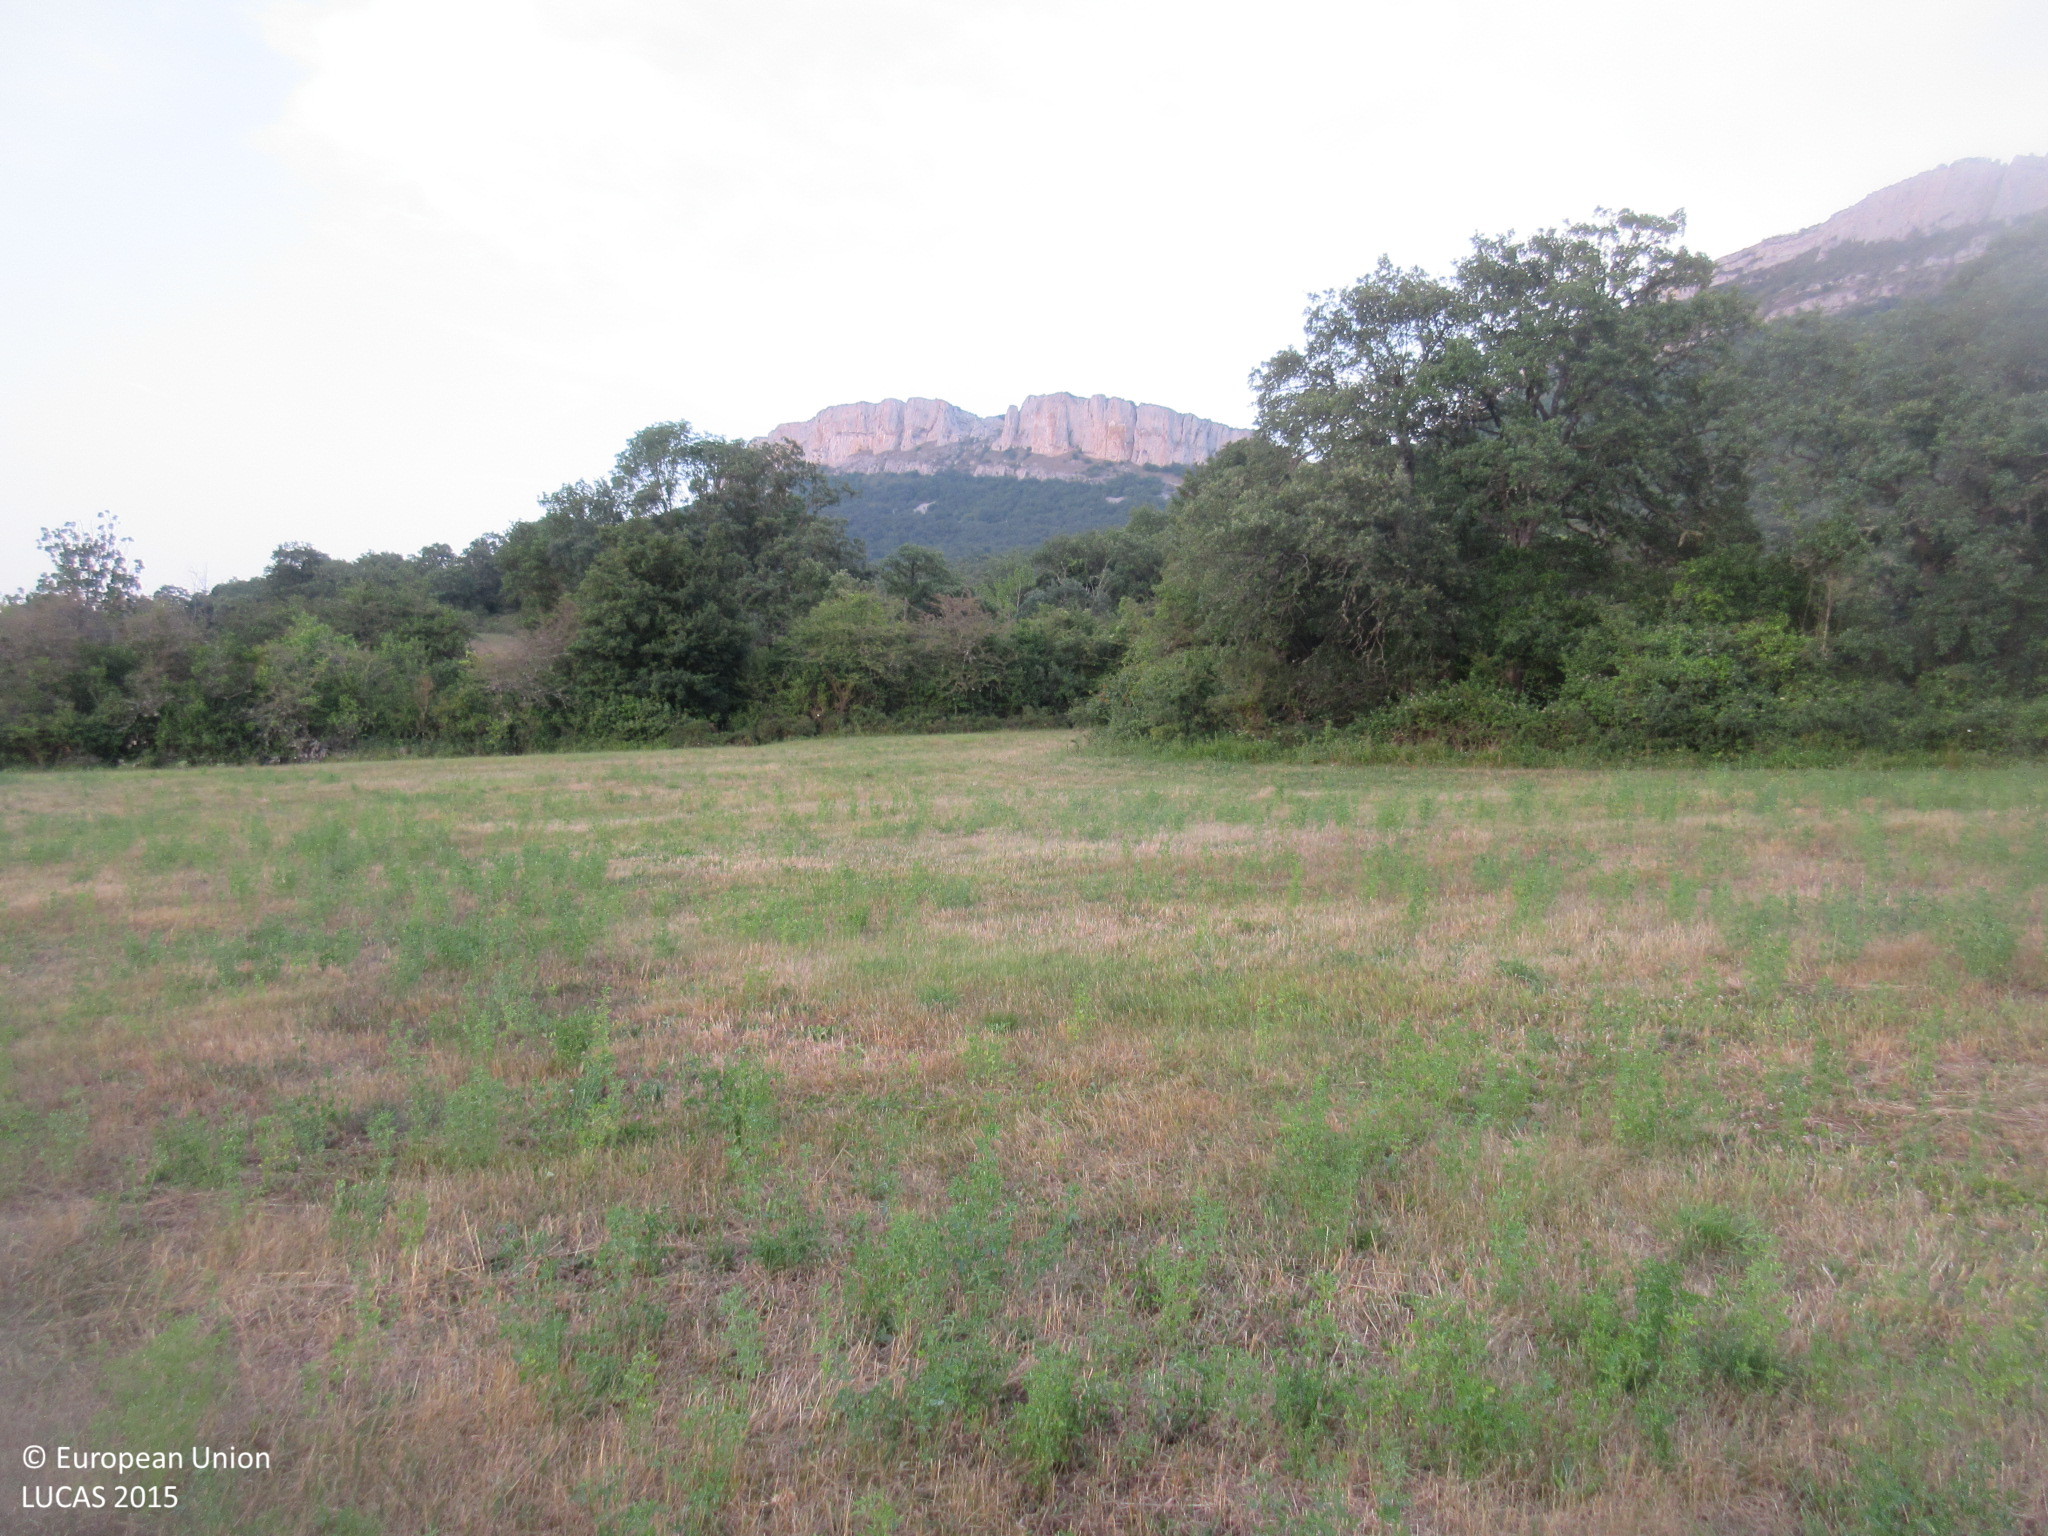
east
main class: Cropland
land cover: Lucerne
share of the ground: 25 - 50 %
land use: Agriculture (excluding fallow land and kitchen gardens)
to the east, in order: Lucerne; Abandoned hedges; Grassland without tree/shrub cover; Broadleaved woodland; Grassland without tree/shrub cover; Shrubland with sparse tree cover; Broadleaved woodland
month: July
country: ES
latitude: 43.0668
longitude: -3.4620
